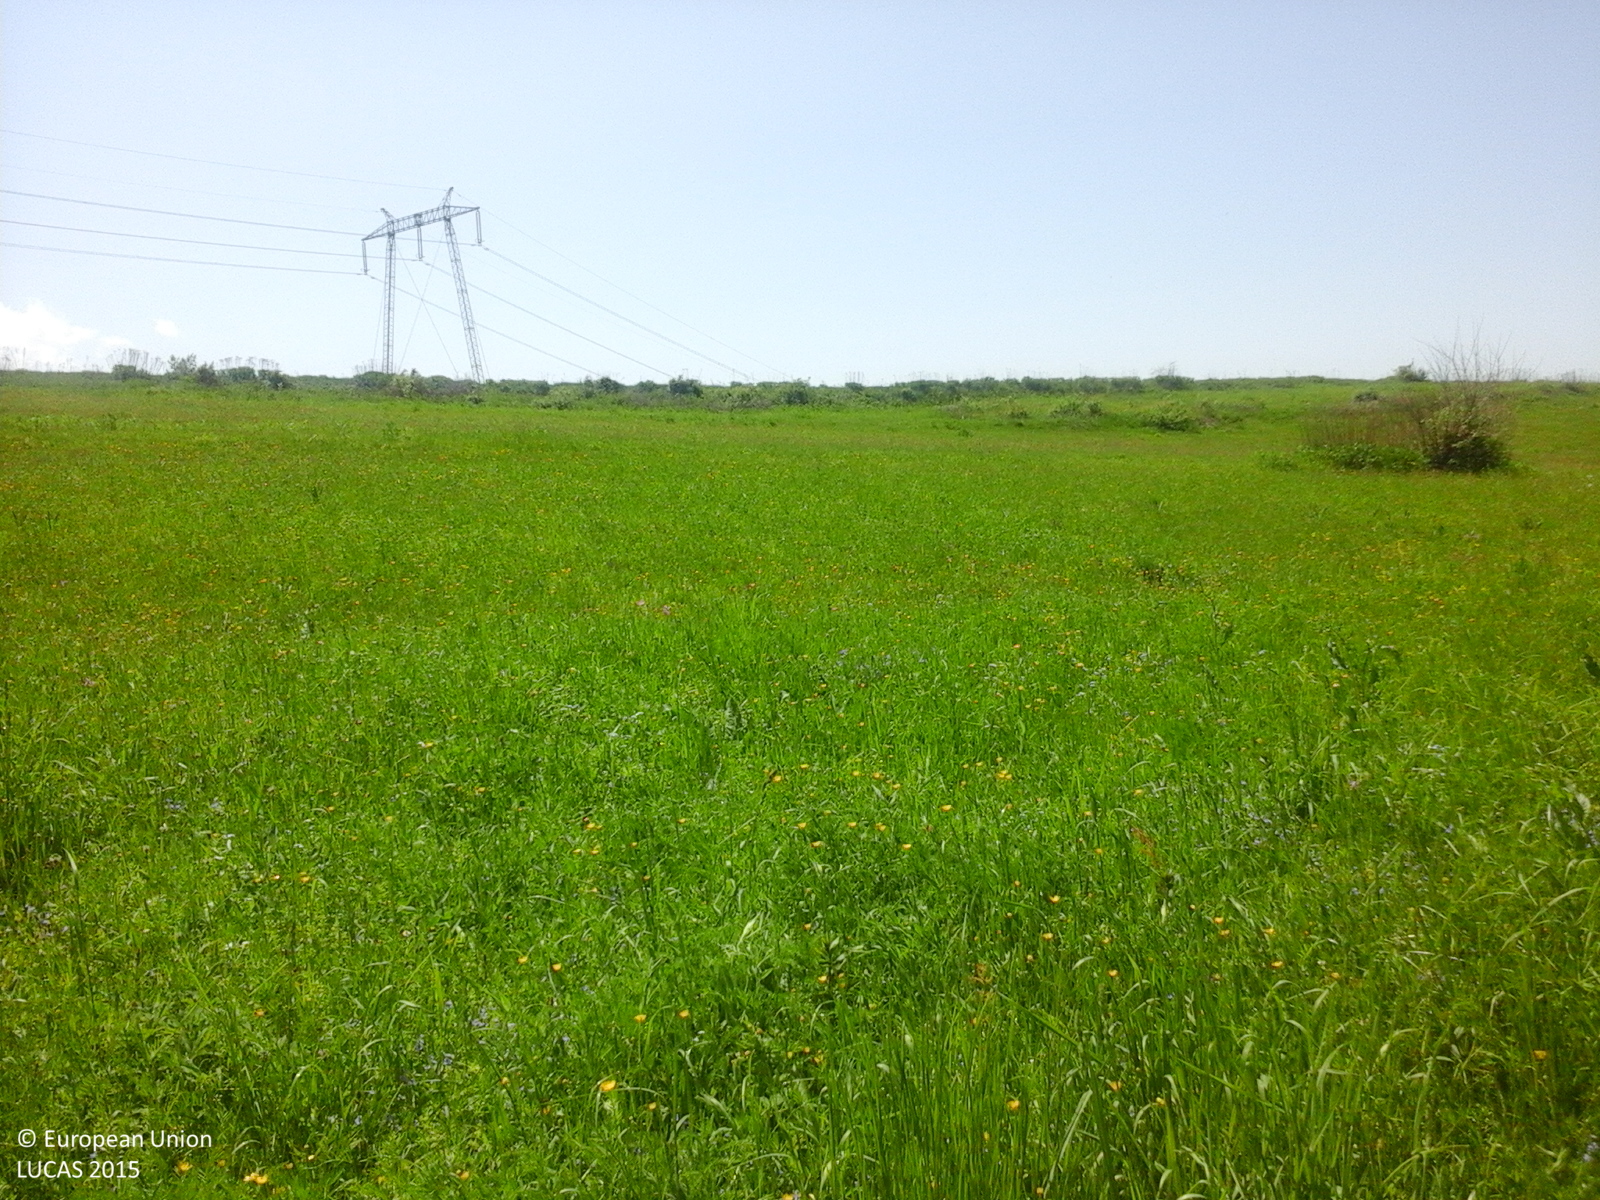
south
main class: Grassland
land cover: Grassland without tree/shrub cover
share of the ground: > 75 %
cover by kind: herbaceous plants 100 %
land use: Agriculture (excluding fallow land and kitchen gardens)
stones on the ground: < 10 %
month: May
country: RO
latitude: 46.0286
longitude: 26.2864
